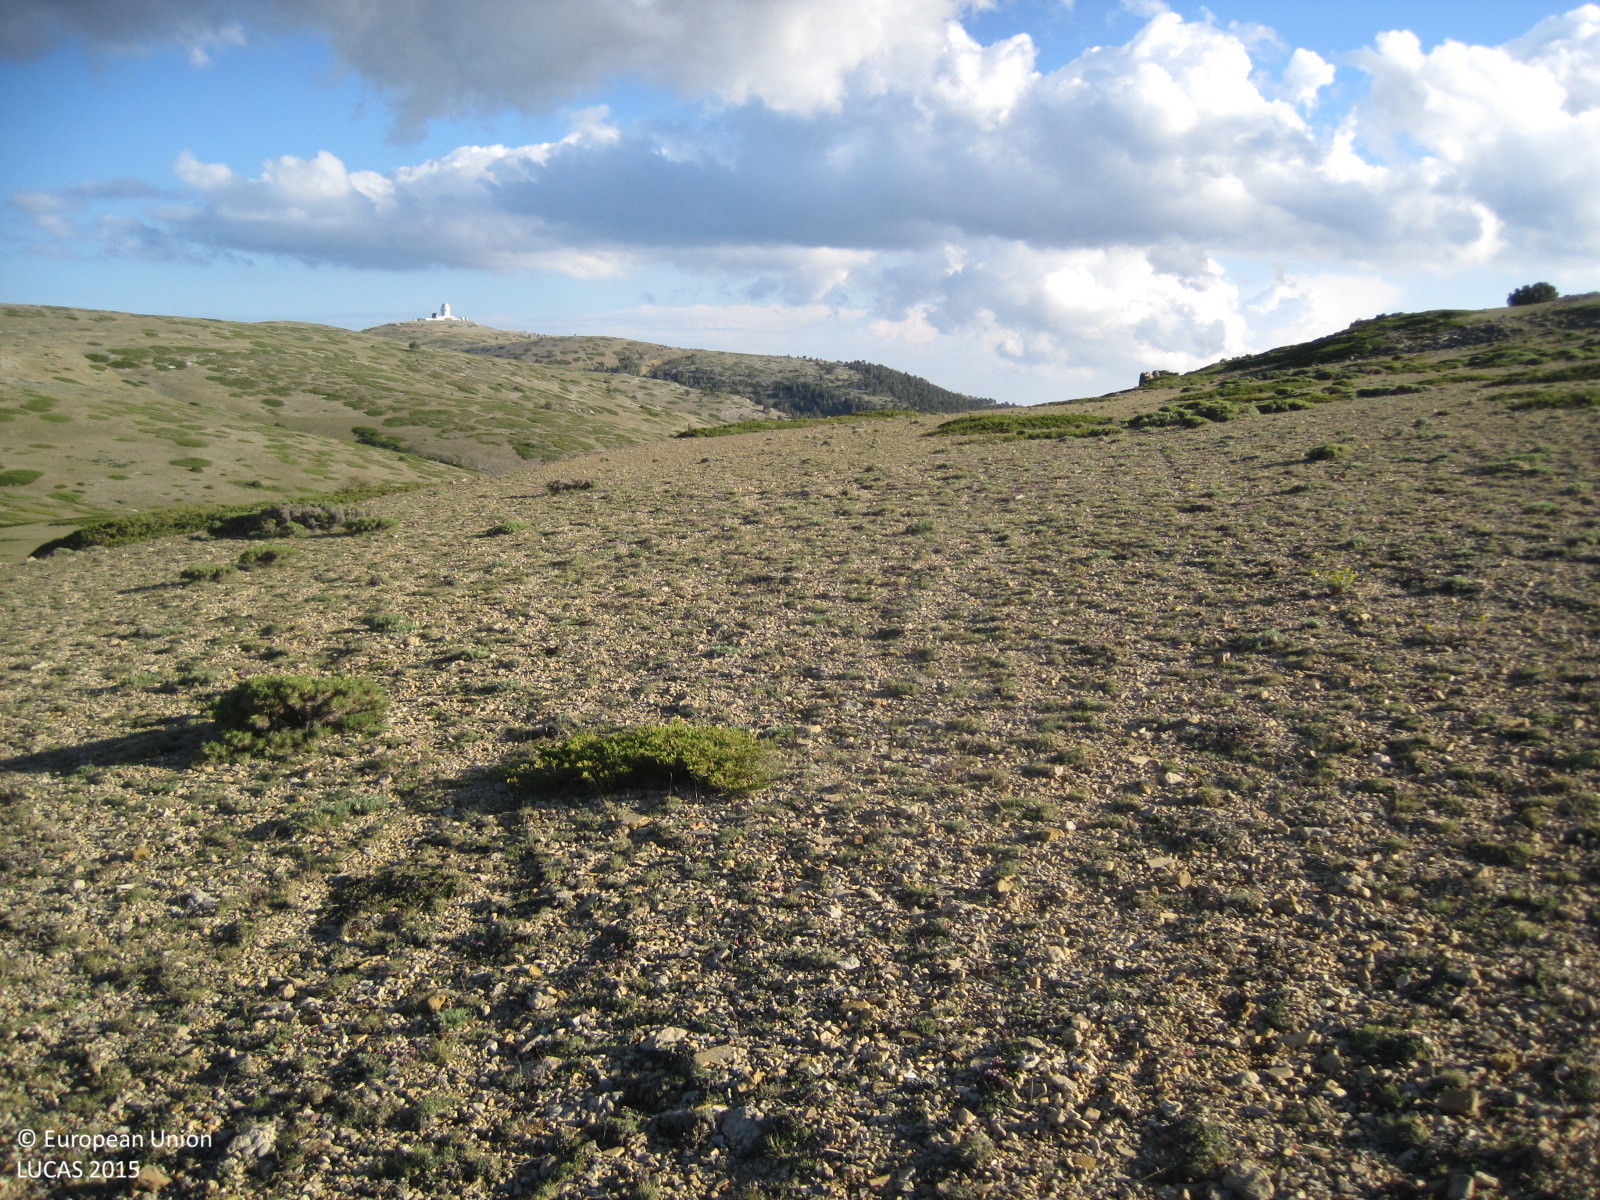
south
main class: Grassland
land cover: Grassland without tree/shrub cover
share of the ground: 50 - 75 %
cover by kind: herbaceous plants 50 %, consolidated bare surface 45 %, shrubs 5 %
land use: Semi-natural and natural areas not in use
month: June
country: ES
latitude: 40.0646
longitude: -1.0162
